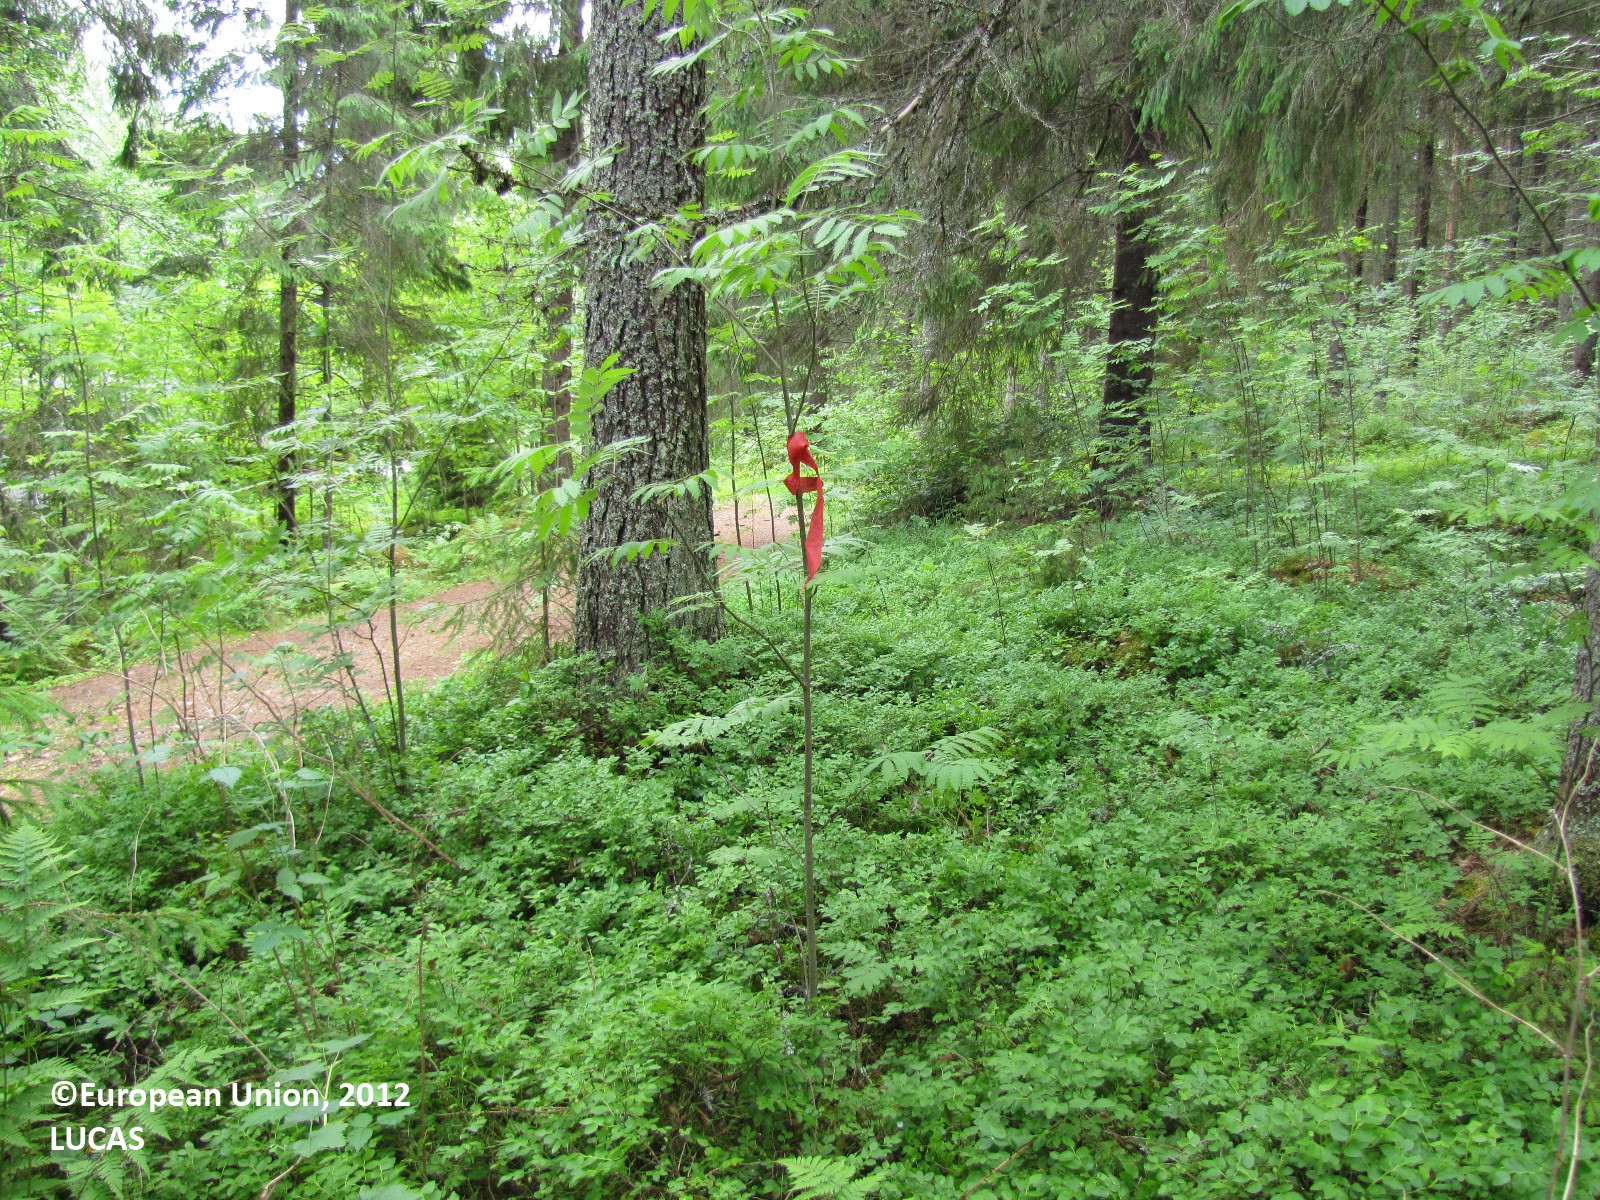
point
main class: Woodland
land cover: Spruce dominated coniferous woodland
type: boreal forest
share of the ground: > 75 %
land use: Forestry
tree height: > 5 m
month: June
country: FI
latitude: 61.2984
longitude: 24.6823
